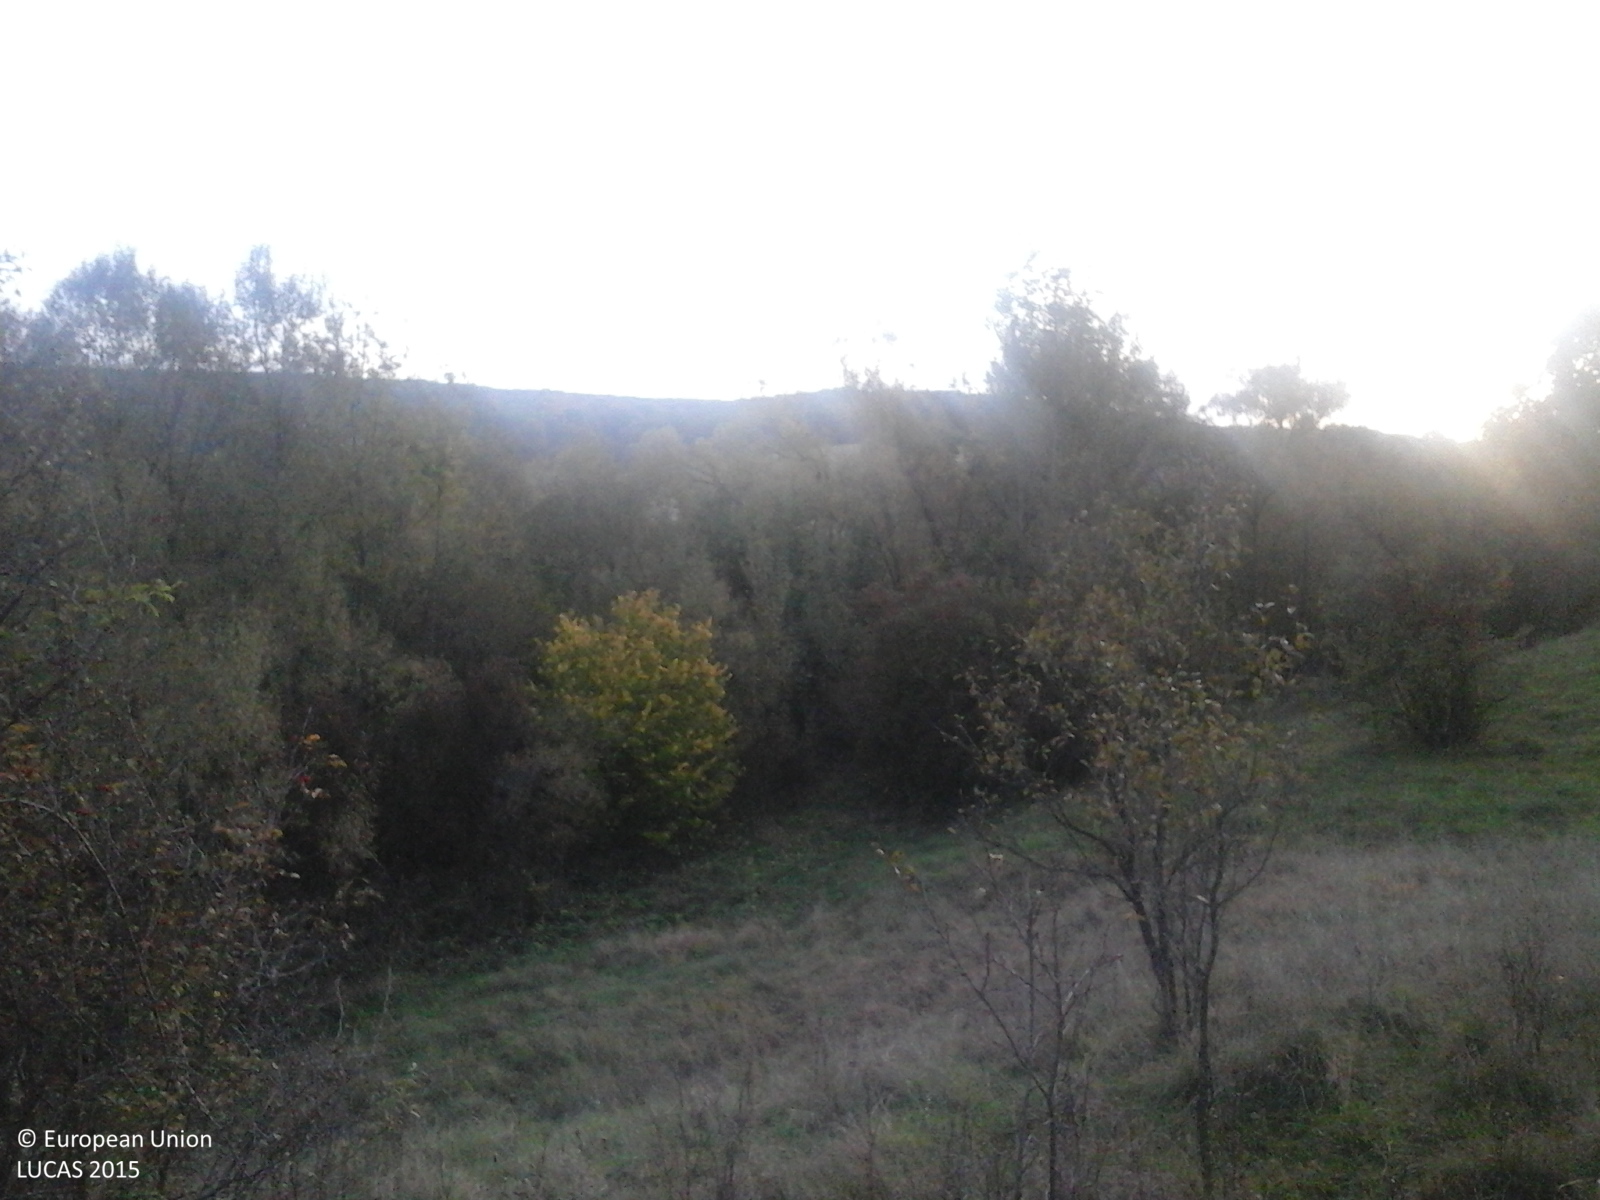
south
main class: Grassland
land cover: Grassland with sparse tree/shrub cover
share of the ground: > 75 %
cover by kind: herbaceous plants 95 %, broadleaved forest trees 5 %
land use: Fallow land
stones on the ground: < 10 %
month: October
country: RO
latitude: 46.1947
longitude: 25.3016
